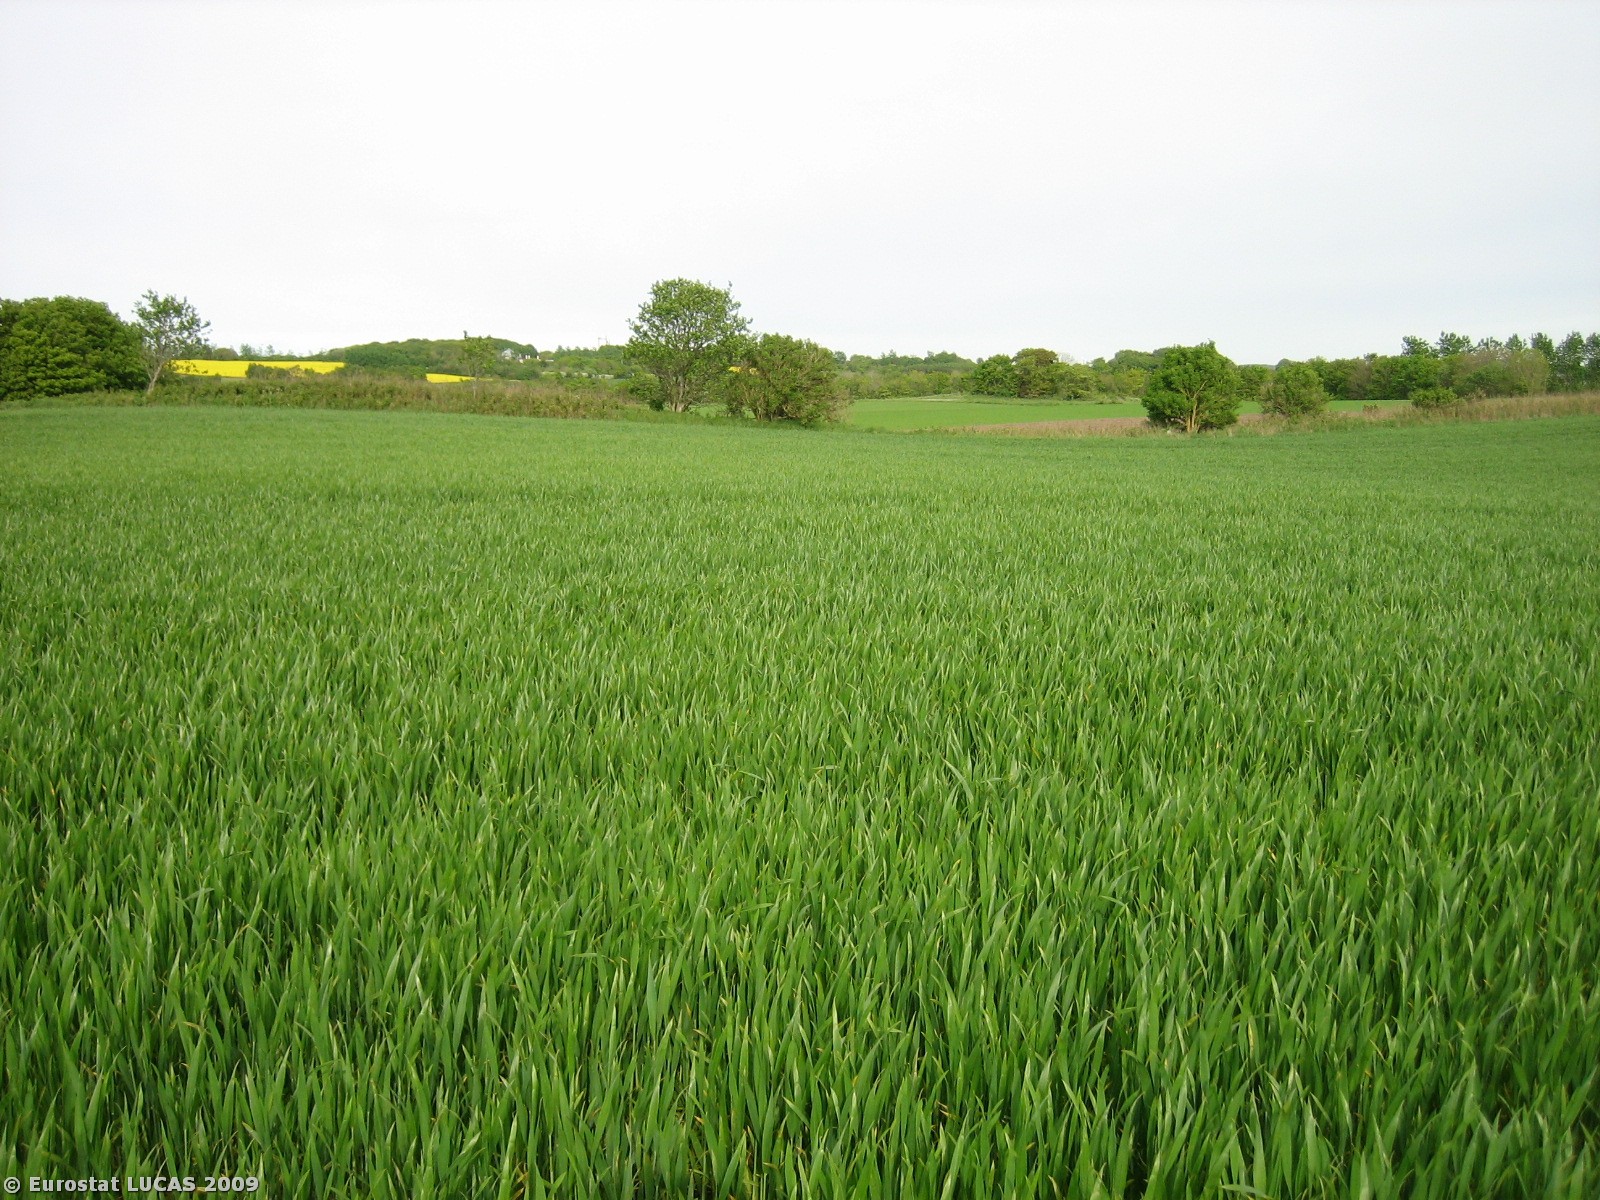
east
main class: Cropland
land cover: Common wheat
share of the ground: > 75 %
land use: Agriculture (excluding fallow land and kitchen gardens)
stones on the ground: < 10 %
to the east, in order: Common wheat; Shrubland with sparse tree cover; Potatoes; Oats
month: May
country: DK
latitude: 56.1247
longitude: 8.4734
